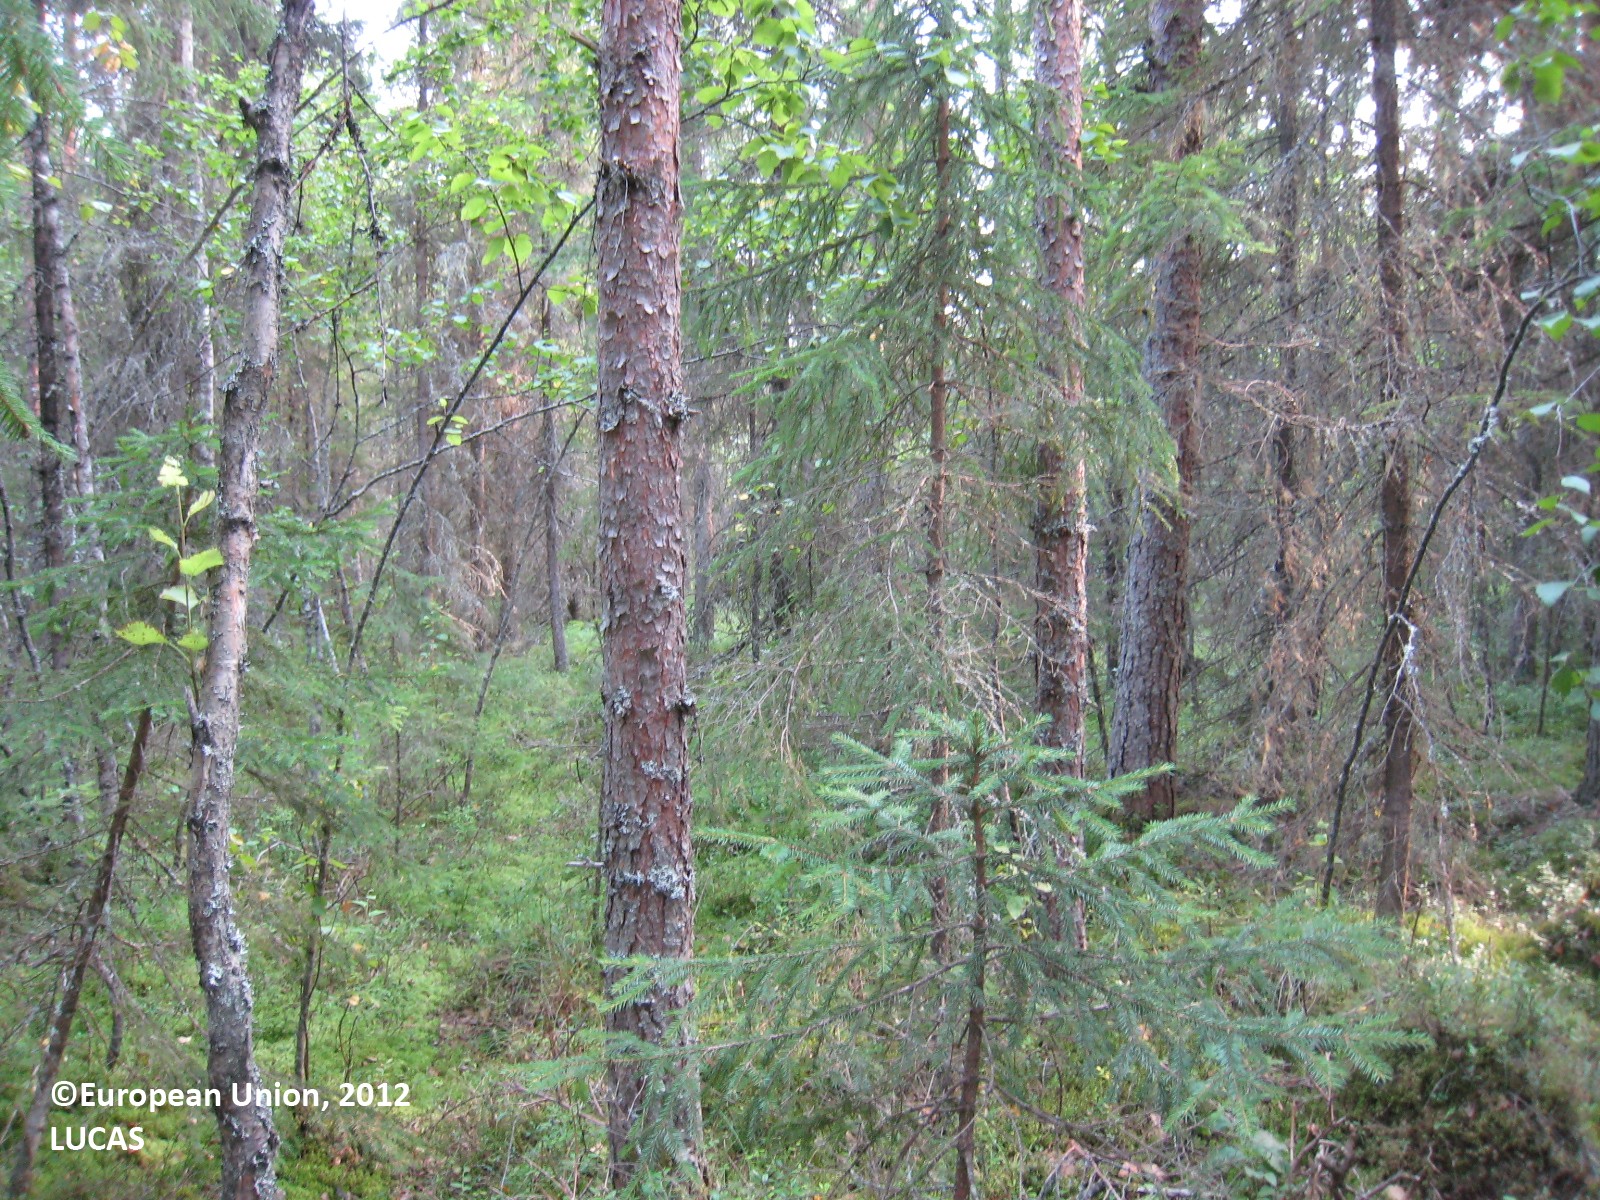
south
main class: Woodland
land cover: Other mixed woodland
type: boreal forest
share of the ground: > 75 %
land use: Forestry
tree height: > 5 m
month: July
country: FI
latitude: 62.6154
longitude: 27.3295
